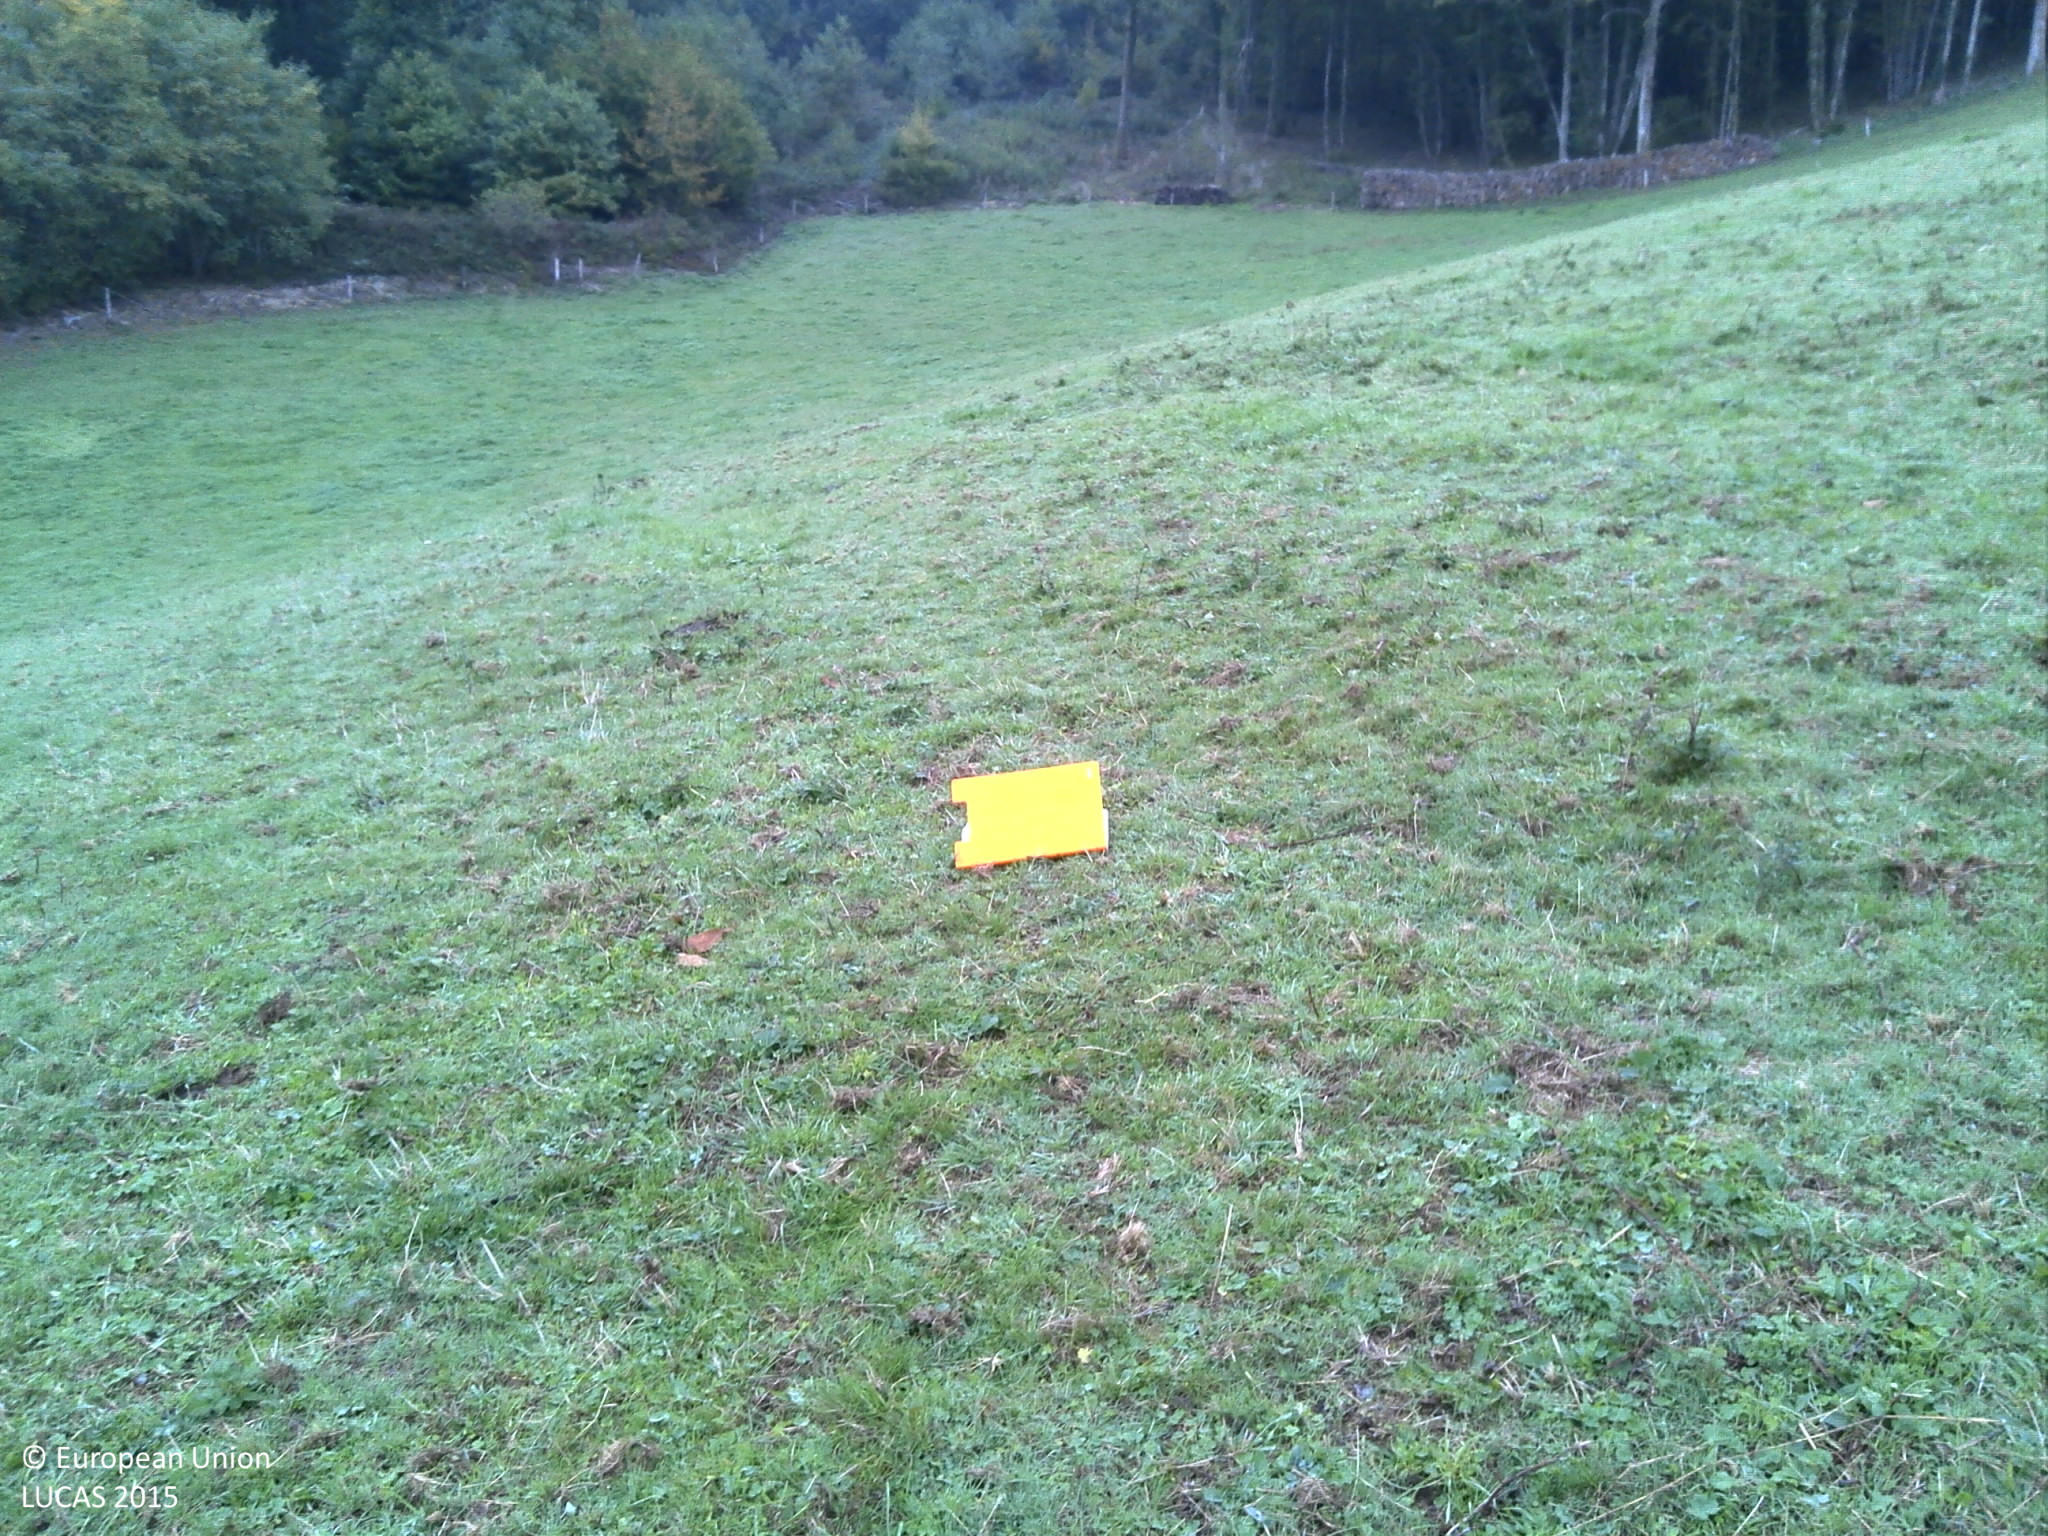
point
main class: Grassland
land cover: Grassland without tree/shrub cover
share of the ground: > 75 %
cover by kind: herbaceous plants 100 %
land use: Agriculture (excluding fallow land and kitchen gardens)
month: October
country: FR
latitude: 46.7615
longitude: 4.0161
